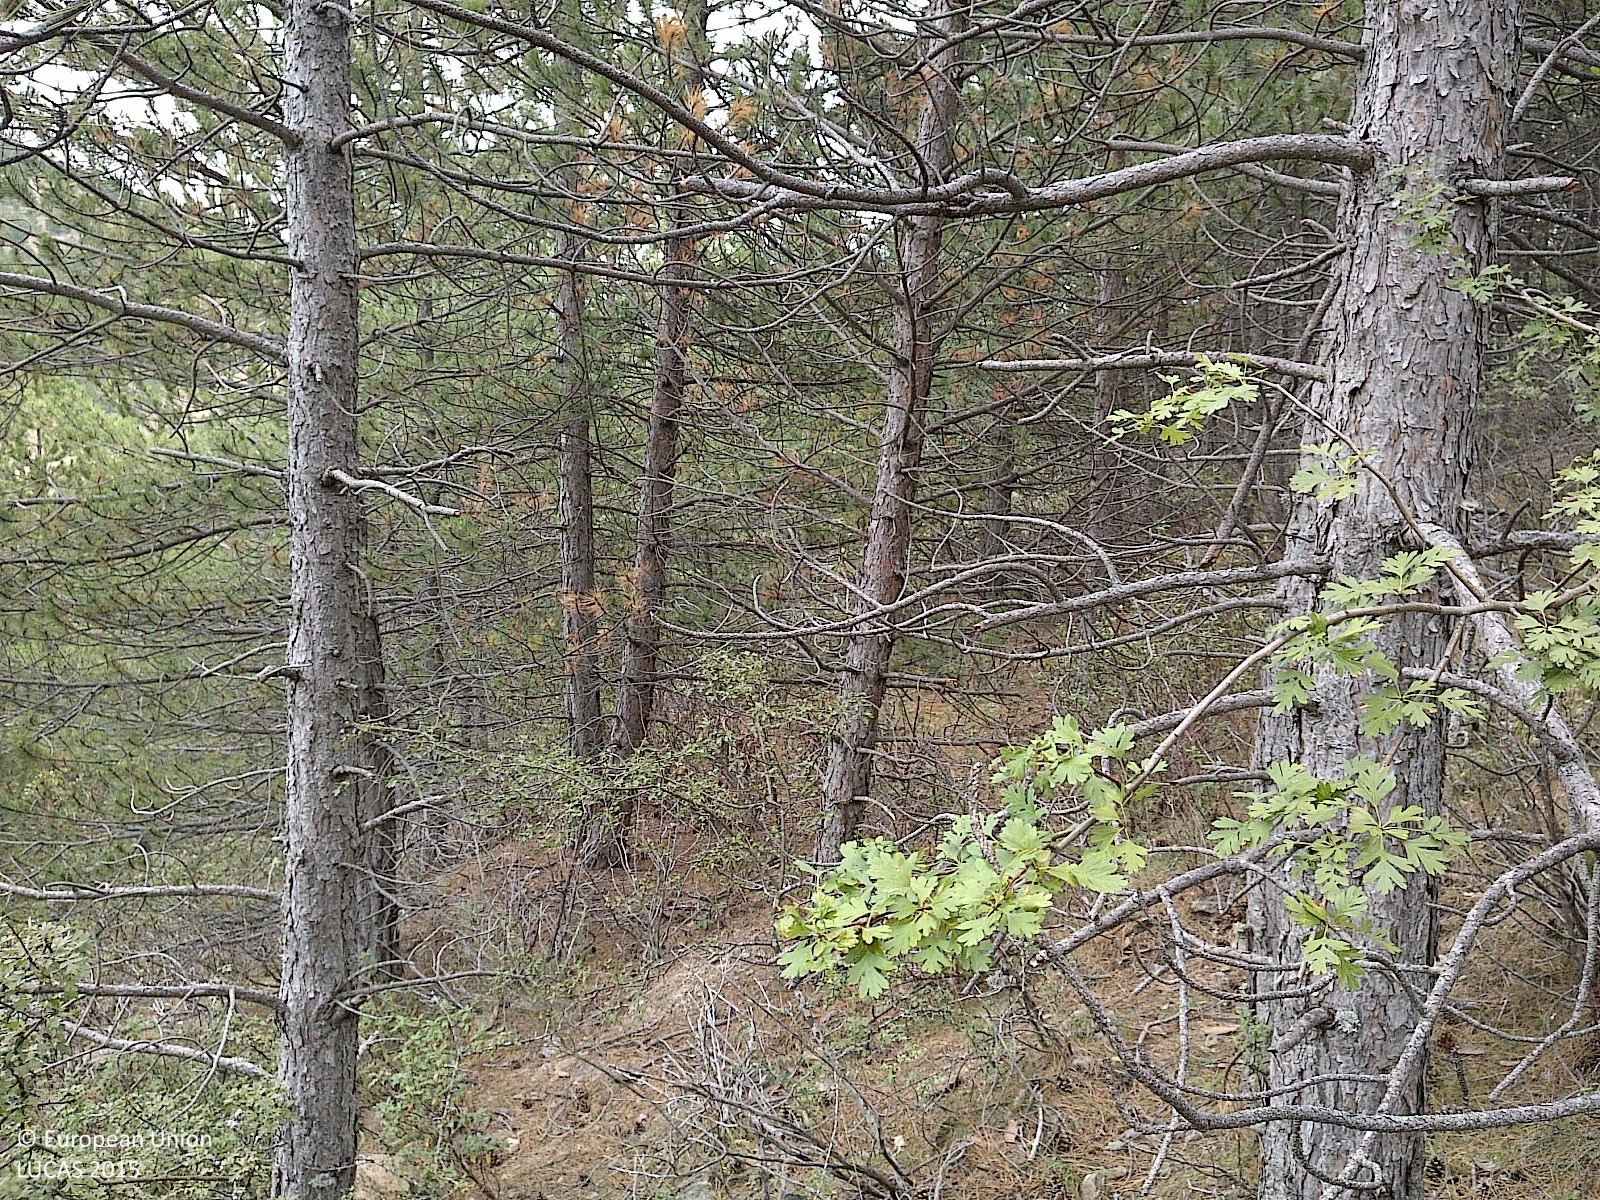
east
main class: Woodland
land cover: Pine dominated coniferous woodland
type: coniferous forest of the mediterranean region
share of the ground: 50 - 75 %
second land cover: Grassland without tree/shrub cover
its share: 25 - 50 %
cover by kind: coniferous forest trees 65 %, shrubs 15 %, herbaceous plants 15 %, consolidated bare surface 5 %
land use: Forestry
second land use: Agriculture (excluding fallow land and kitchen gardens)
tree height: > 5 m
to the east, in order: Pine dominated coniferous woodland; Grassland without tree/shrub cover; Rivers and streams; Pine dominated coniferous woodland
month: July
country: ES
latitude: 42.0736
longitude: -2.2340
